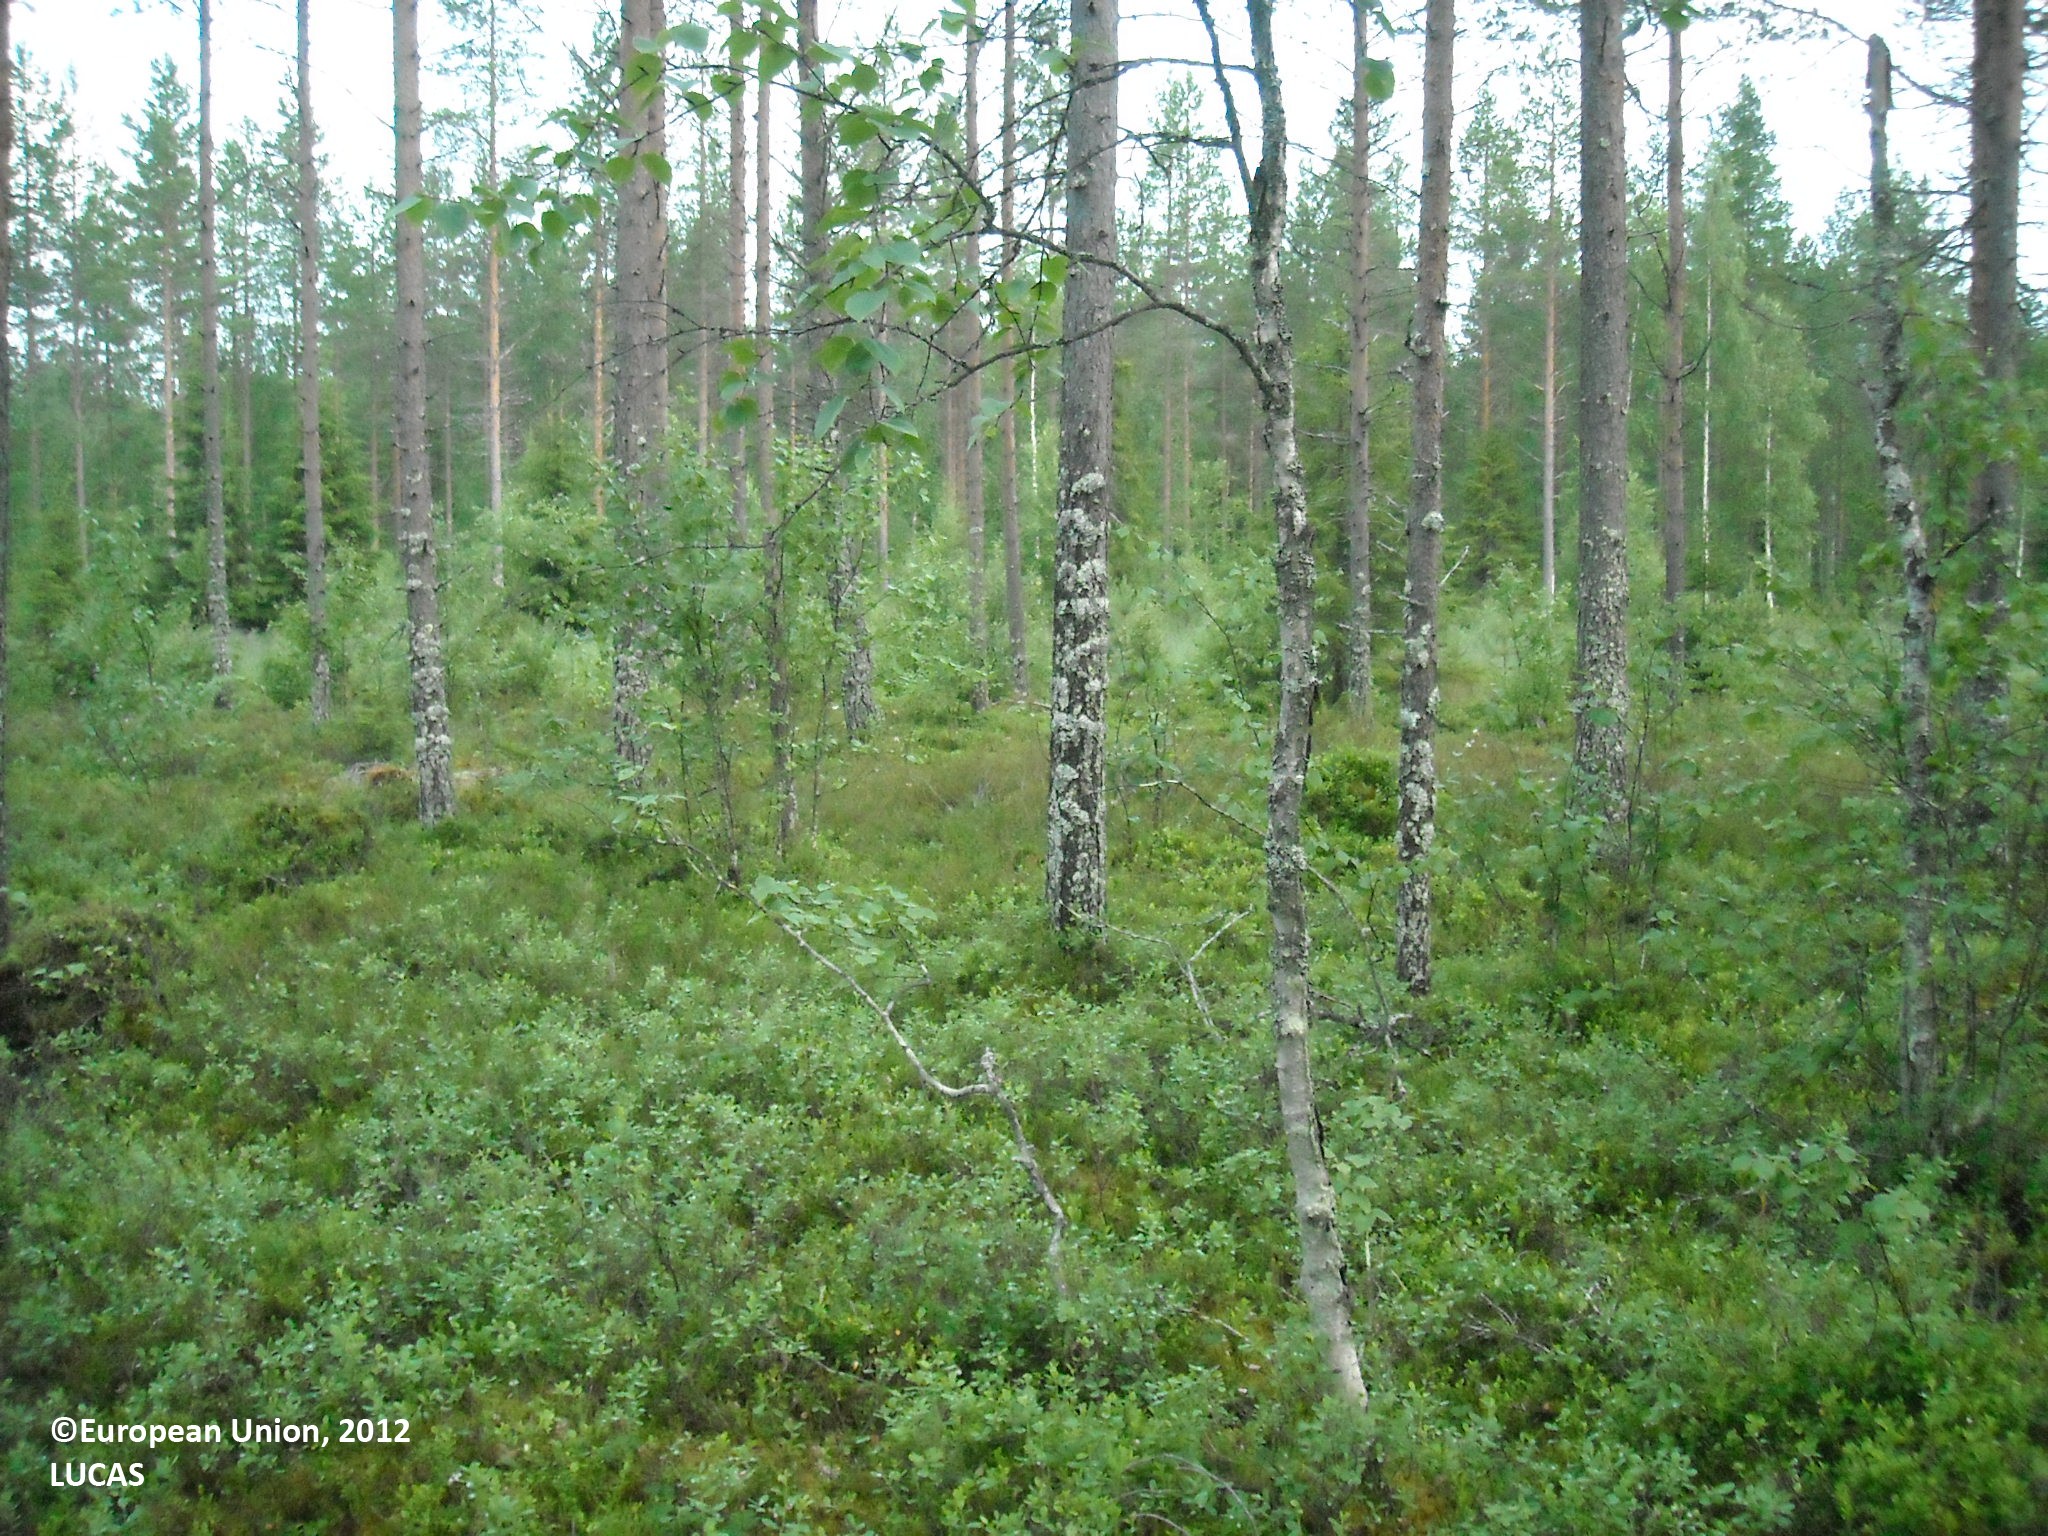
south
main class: Woodland
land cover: Pine dominated coniferous woodland
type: mire and swamp forests
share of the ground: 50 - 75 %
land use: Forestry
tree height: > 5 m
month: July
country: FI
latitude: 64.4549
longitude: 27.6702
